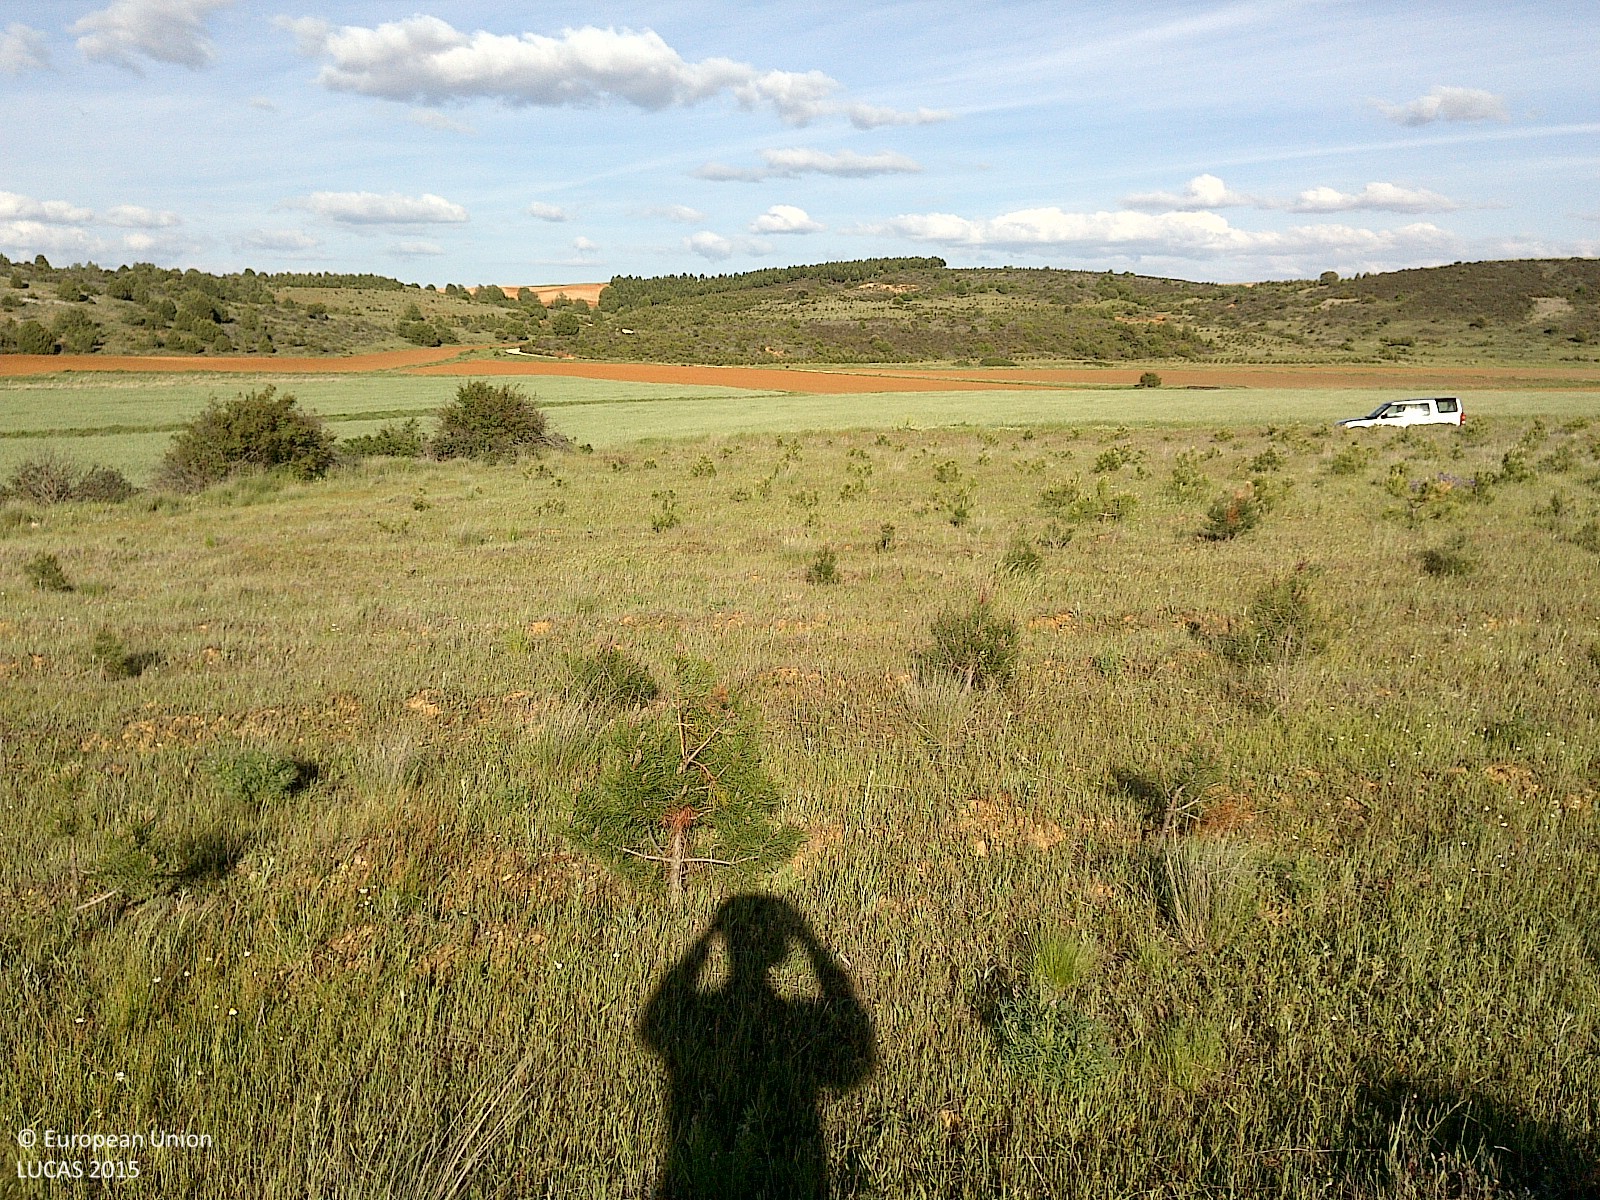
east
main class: Grassland
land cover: Grassland with sparse tree/shrub cover
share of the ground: > 75 %
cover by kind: herbaceous plants 95 %, coniferous forest trees 5 %
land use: Forestry
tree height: < 5 m
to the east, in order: Grassland with sparse tree/shrub cover; Tracks; Grass margins; Rye; Grass margins; Rivers and streams; Grass margins; Rye
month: May
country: ES
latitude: 41.7213
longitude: -3.1360
